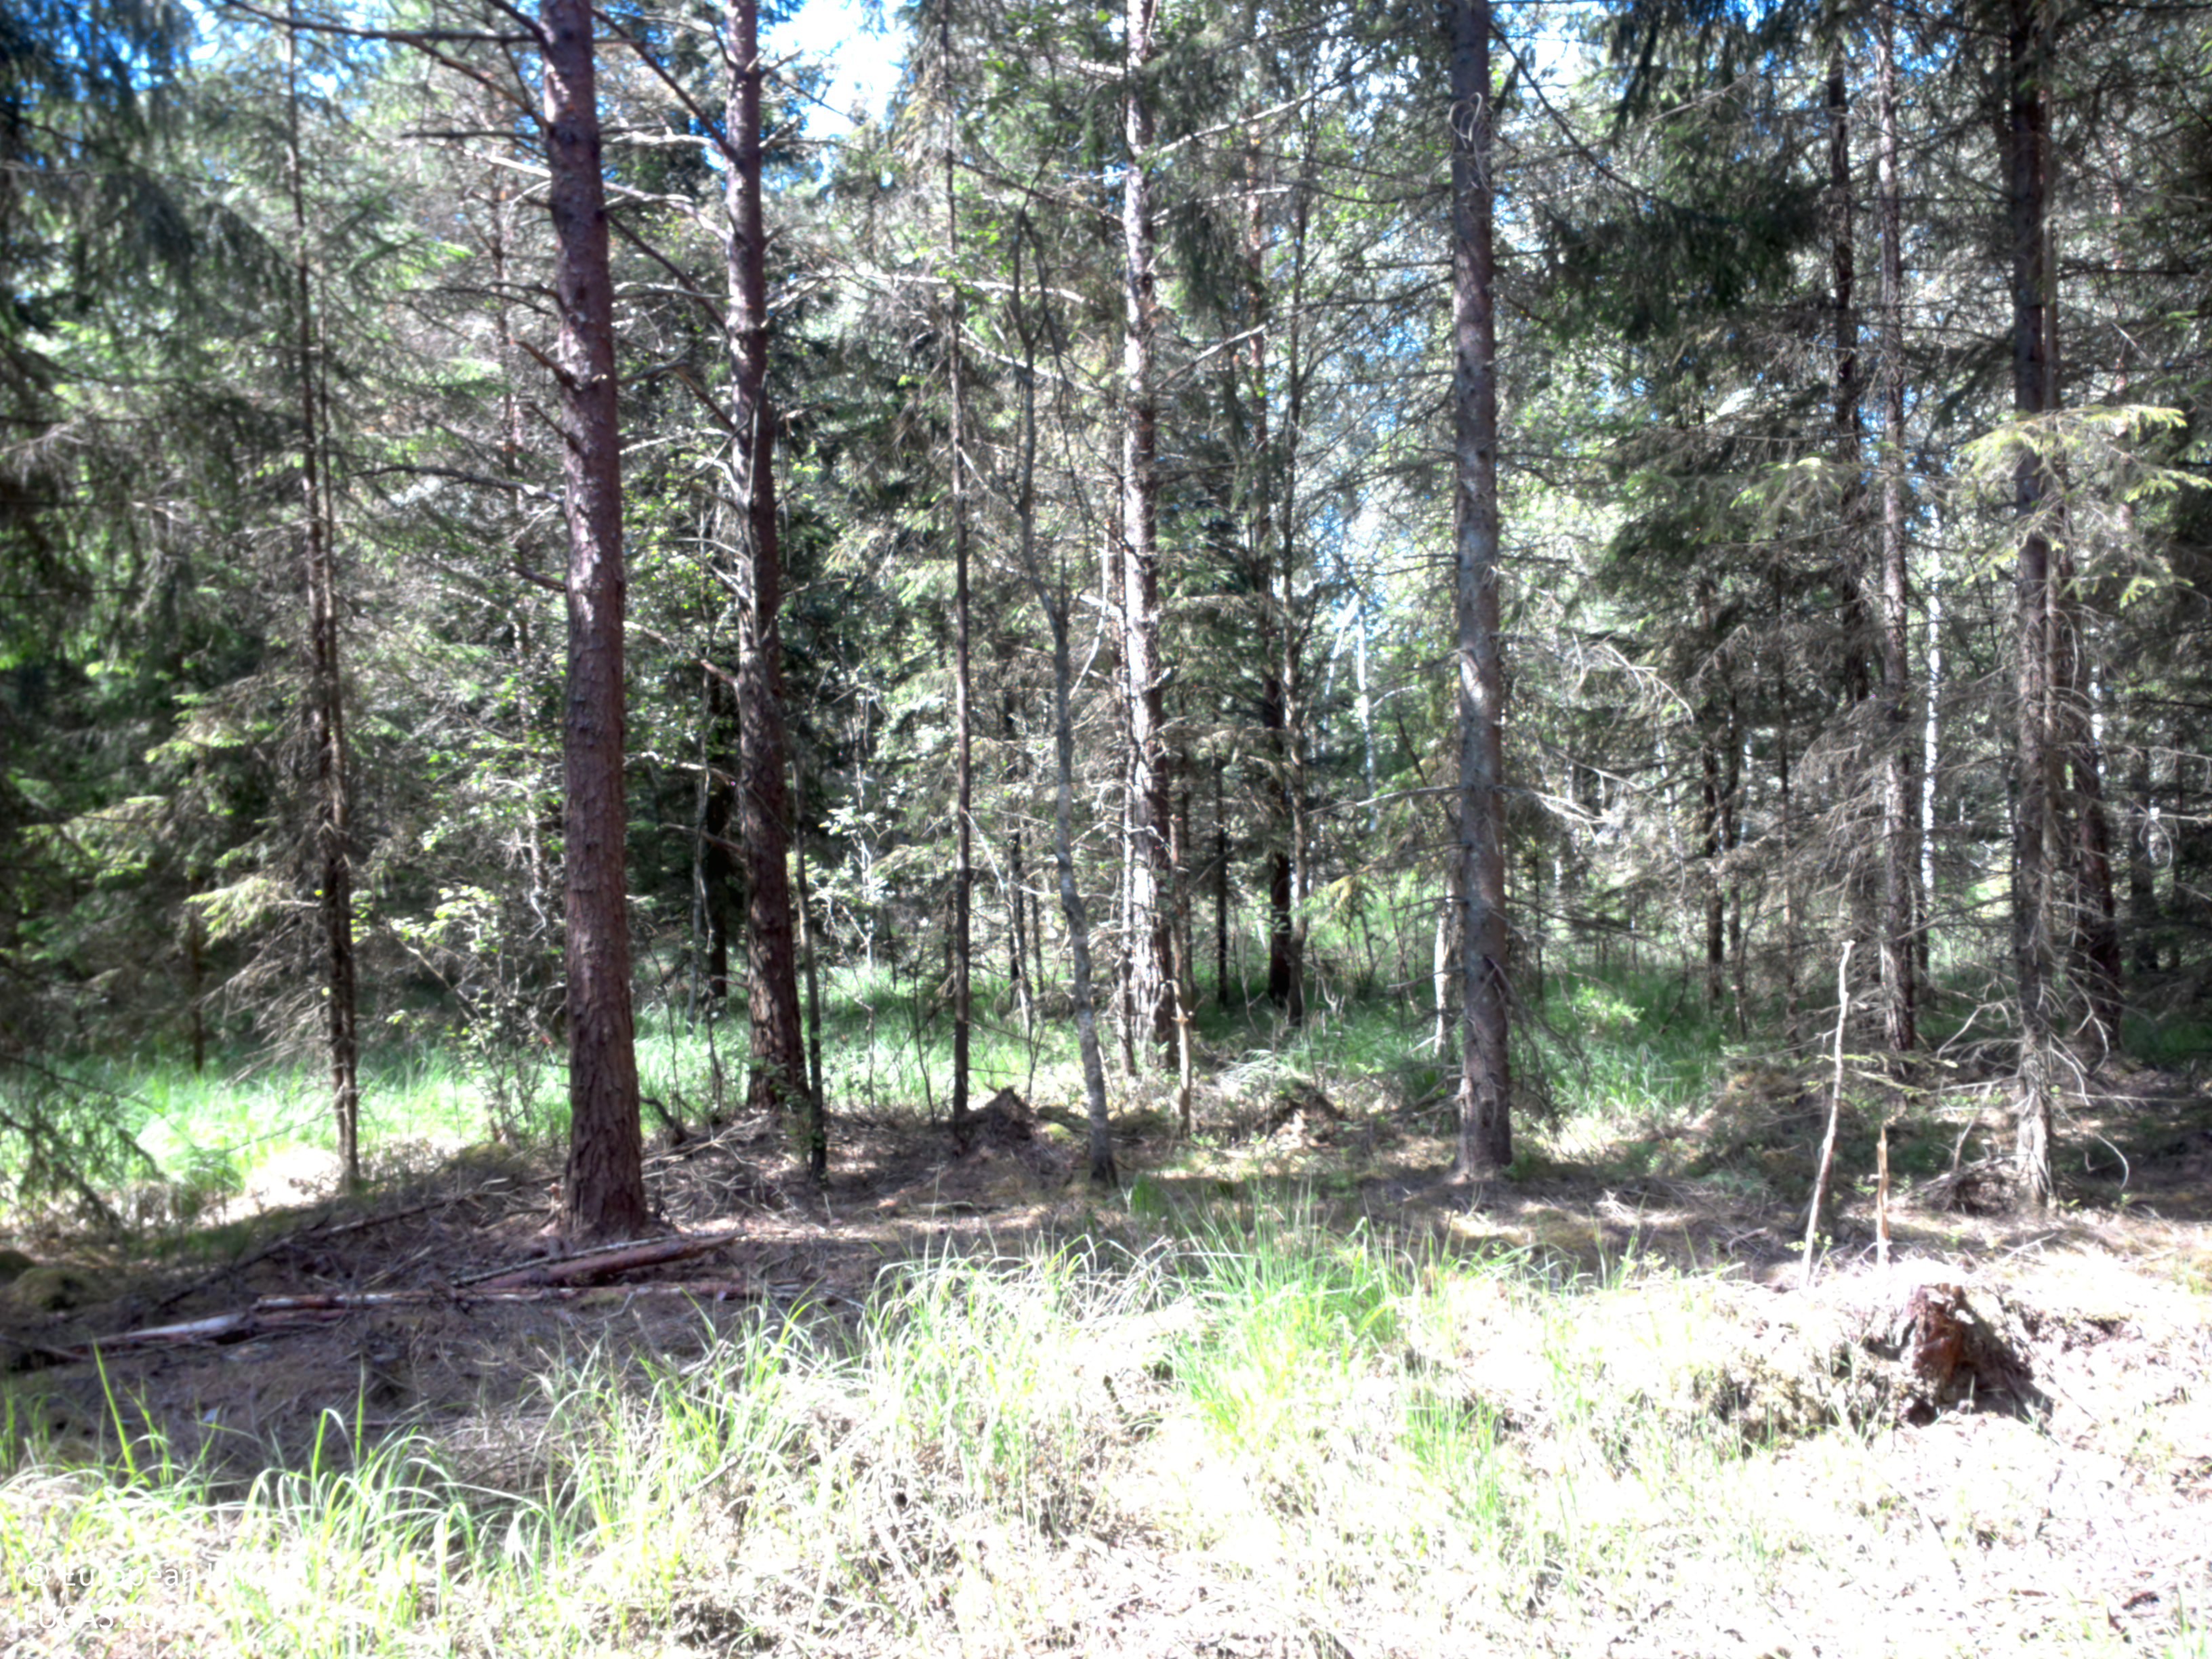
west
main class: Woodland
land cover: Spruce dominated coniferous woodland
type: boreal forest
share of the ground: 50 - 75 %
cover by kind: coniferous forest trees 50 %, herbaceous plants 30 %, lichens and mosses 20 %
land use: Forestry
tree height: > 5 m
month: July
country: SE
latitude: 57.9118
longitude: 12.3083
